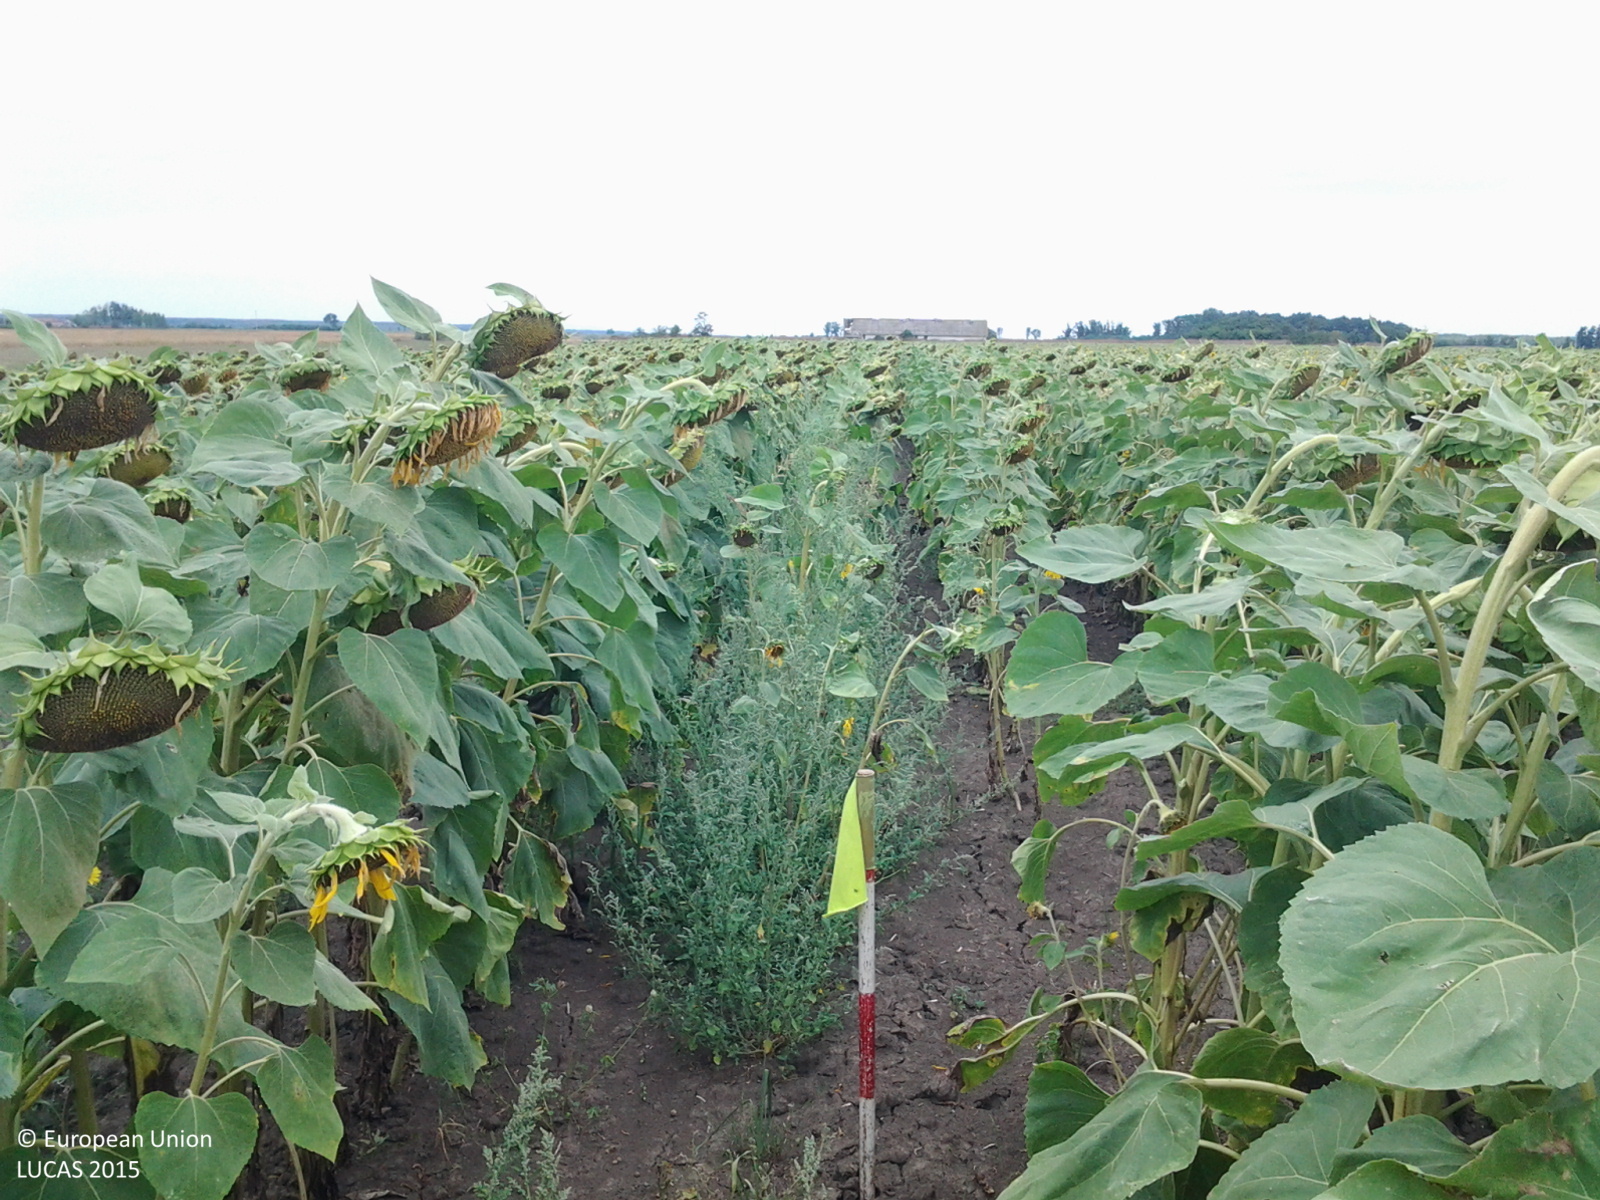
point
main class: Cropland
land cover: Sunflower
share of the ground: > 75 %
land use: Agriculture (excluding fallow land and kitchen gardens)
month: July
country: HU
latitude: 47.3016
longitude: 20.5182
